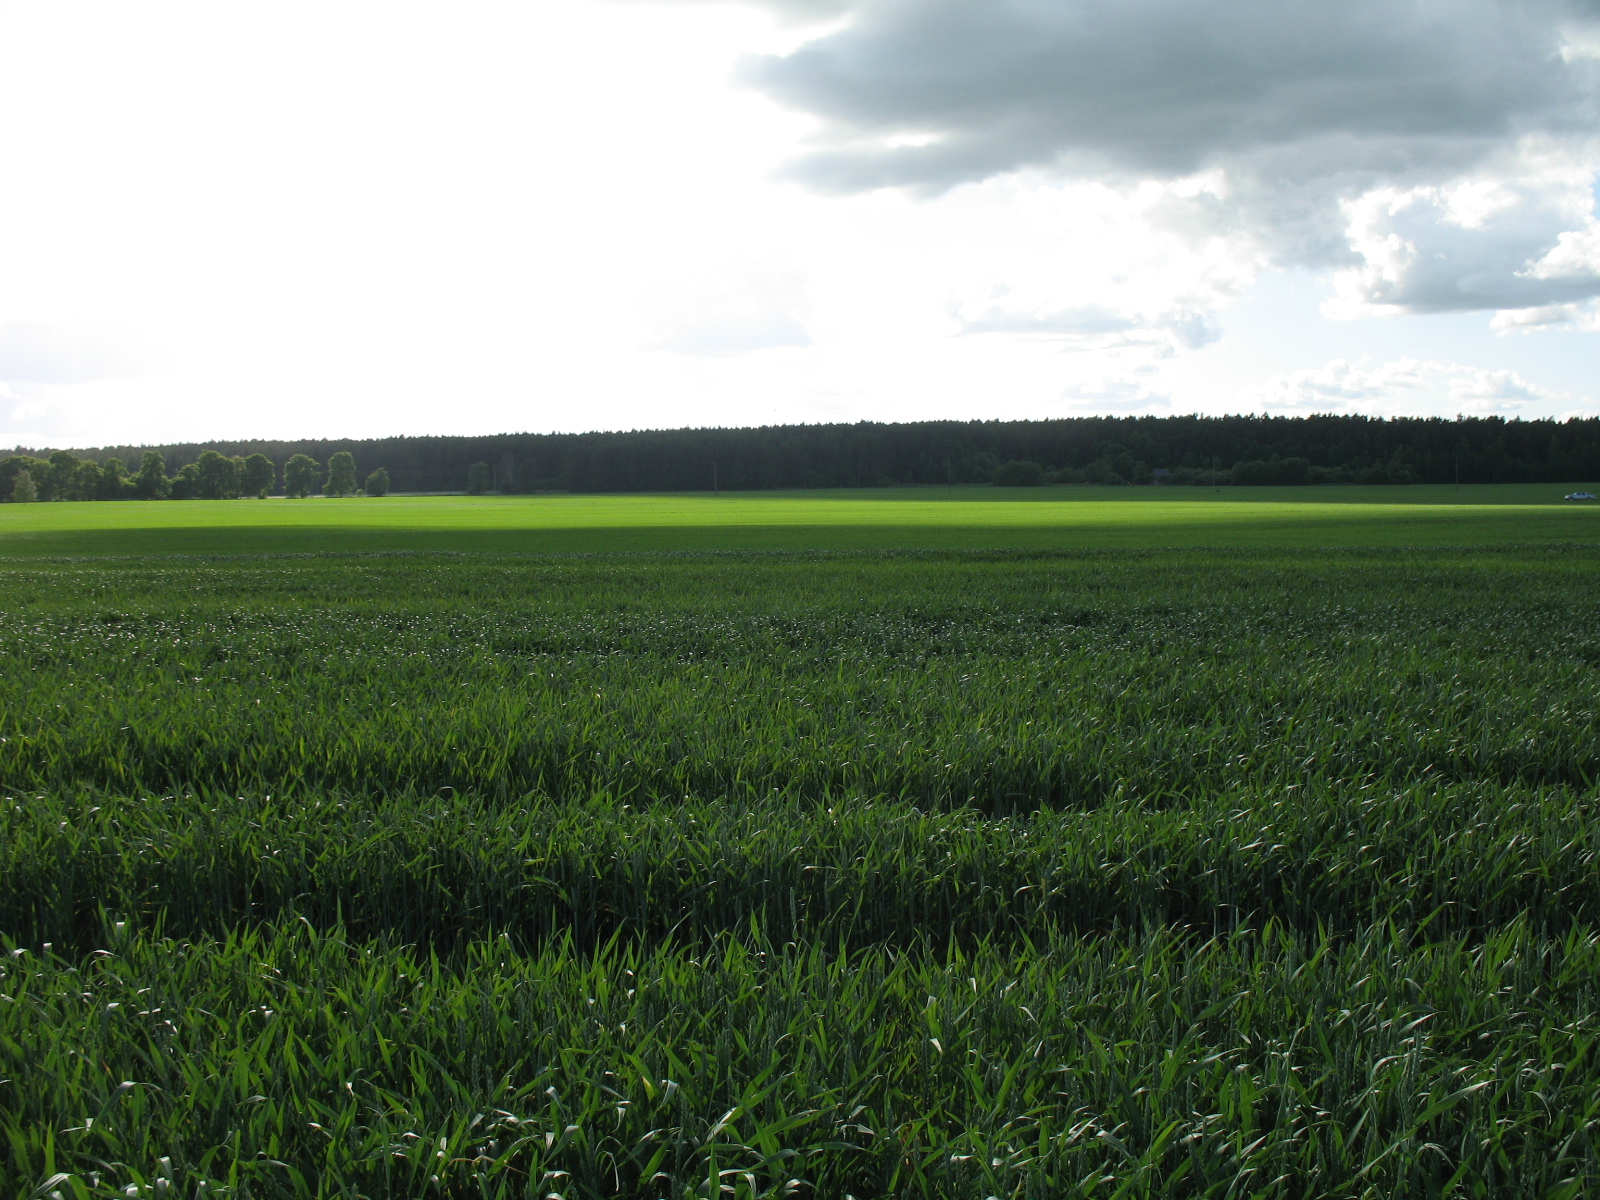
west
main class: Cropland
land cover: Common wheat
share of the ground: > 75 %
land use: Agriculture (excluding fallow land and kitchen gardens)
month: June
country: LV
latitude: 56.4633
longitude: 23.4309
